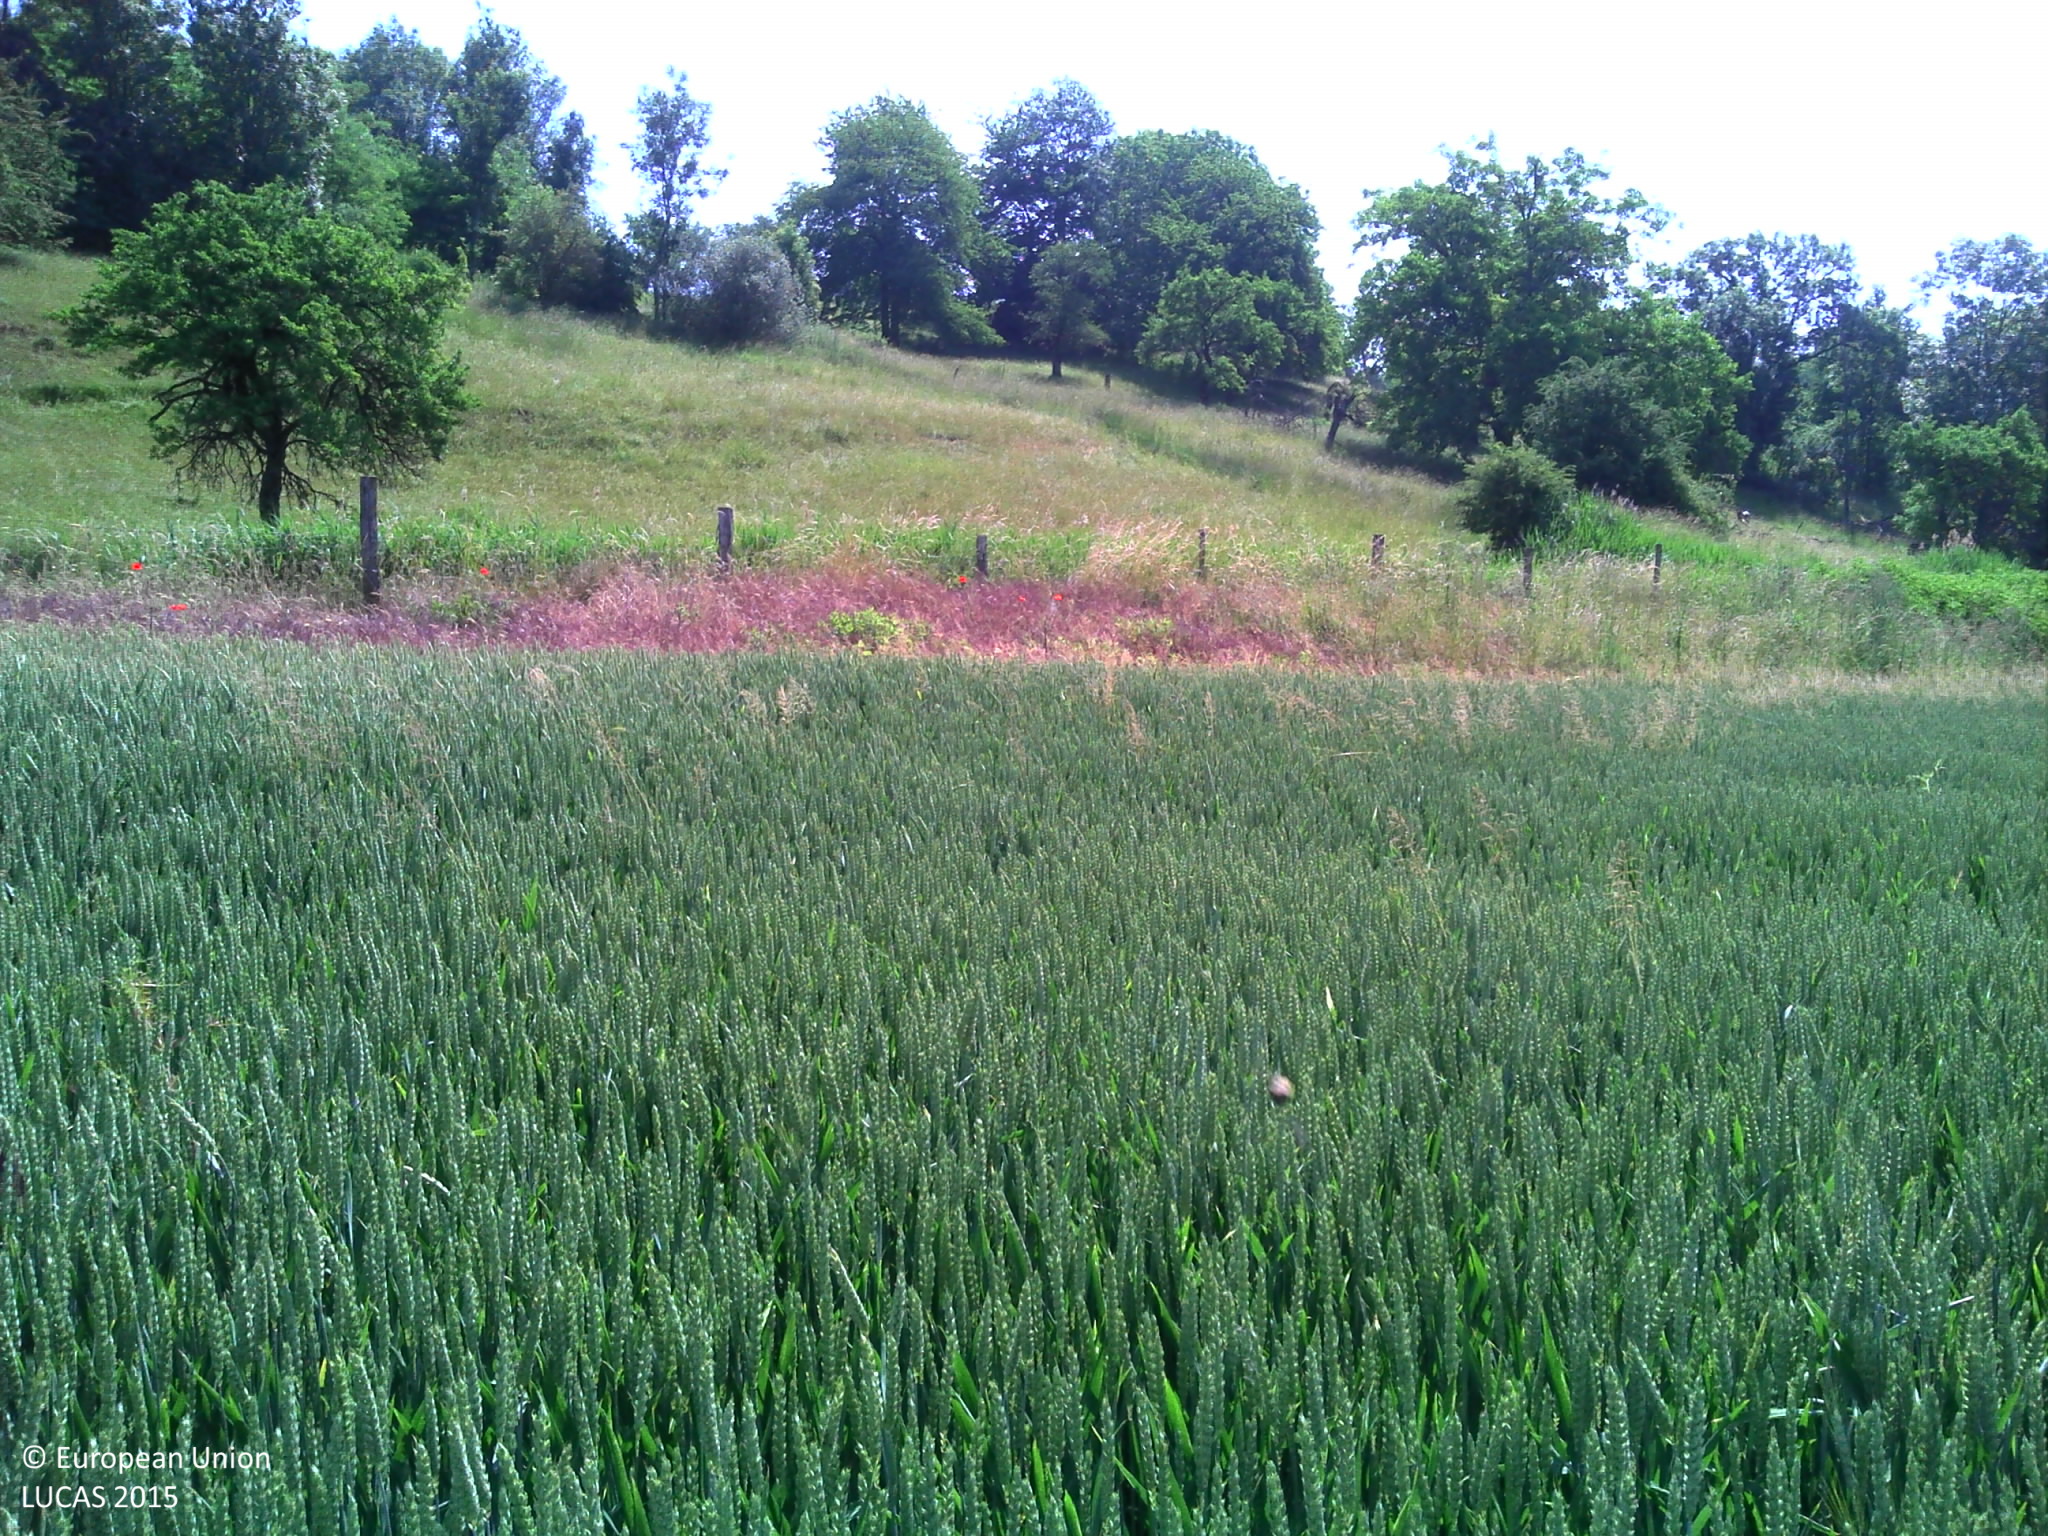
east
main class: Cropland
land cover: Common wheat
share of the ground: > 75 %
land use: Agriculture (excluding fallow land and kitchen gardens)
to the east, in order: Common wheat; Spontaneously vegetated surfaces; Fences; Grass margins; Paved roads, cycling and walking lanes; Grass margins; Ditches and canals; Fences; Grassland with sparse tree/shrub cover; Broadleaved woodland; Fences; Broadleaved woodland; Grassland with sparse tree/shrub cover; Broadleaved woodland; Ditches and canals; Broadleaved woodland; Fences; Grassland with sparse tree/shrub cover; Fences; Tracks; Fences; Apple fruit
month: June
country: FR
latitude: 48.4859
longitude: 6.3066
